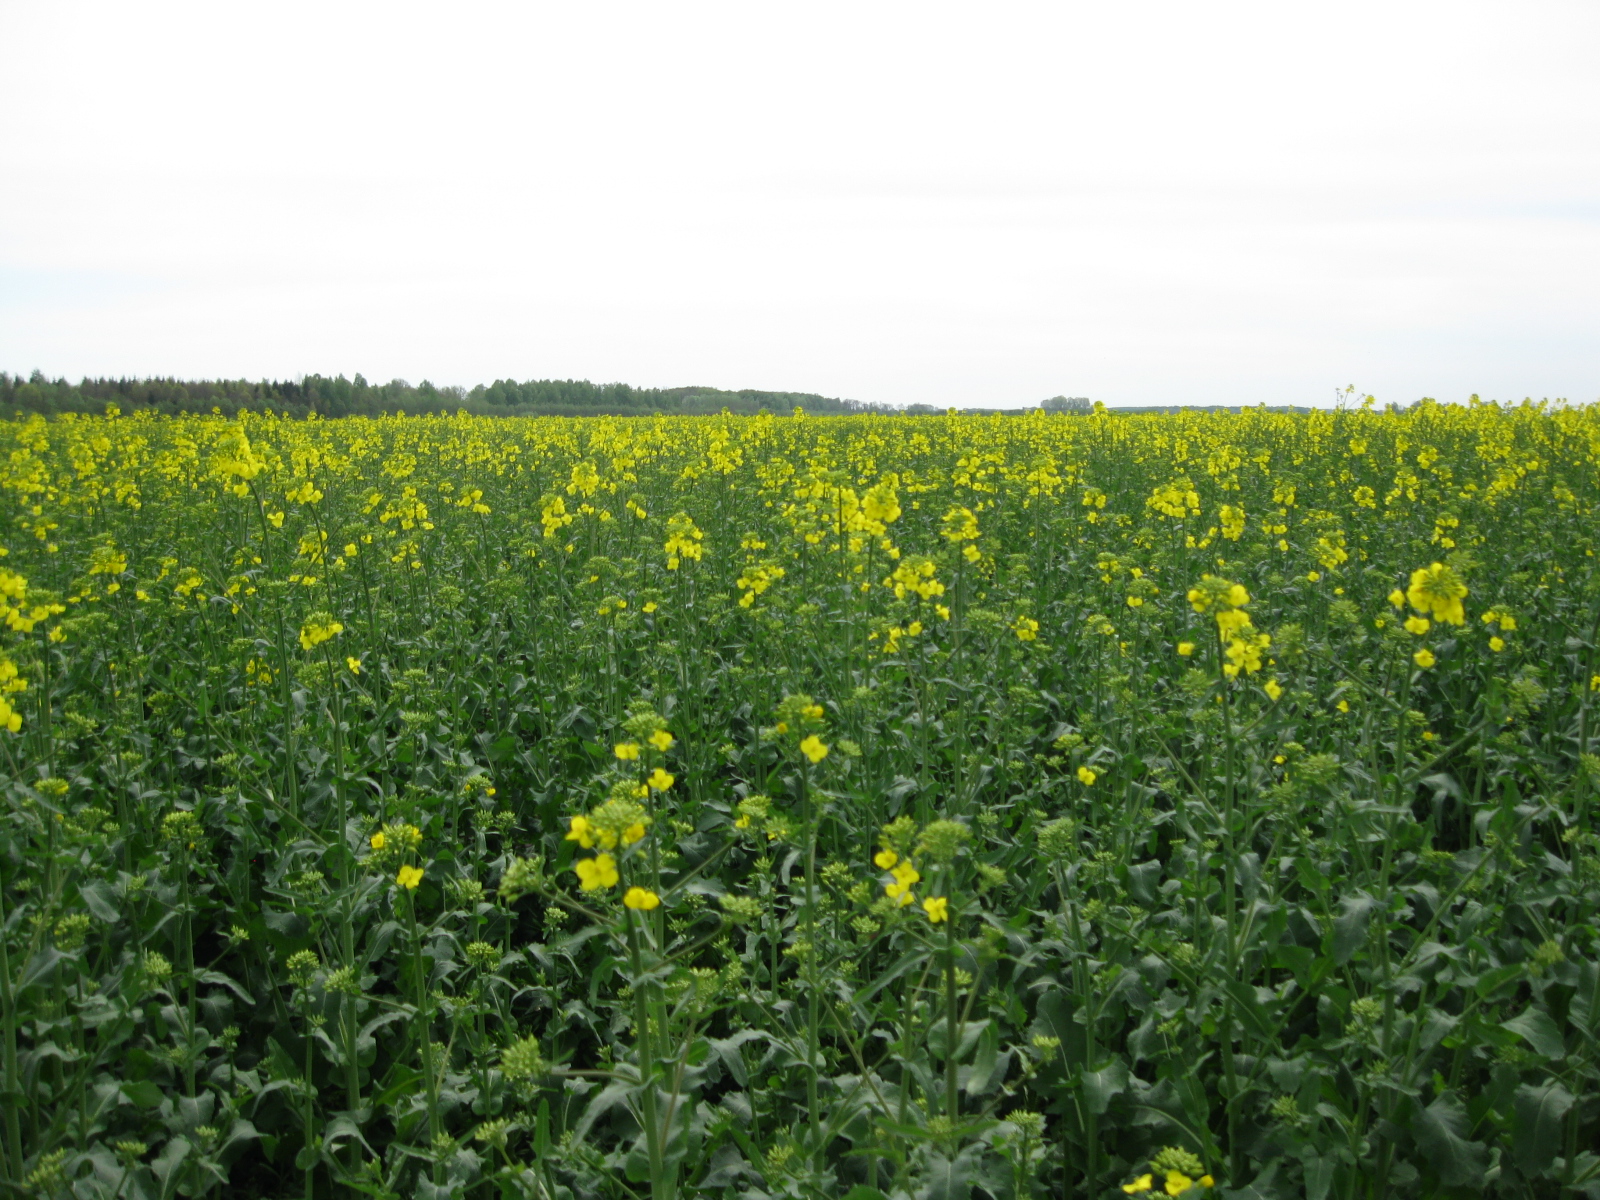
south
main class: Cropland
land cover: Rape and turnip rape
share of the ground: > 75 %
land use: Agriculture (excluding fallow land and kitchen gardens)
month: May
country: LT
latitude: 56.2647
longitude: 24.2510
